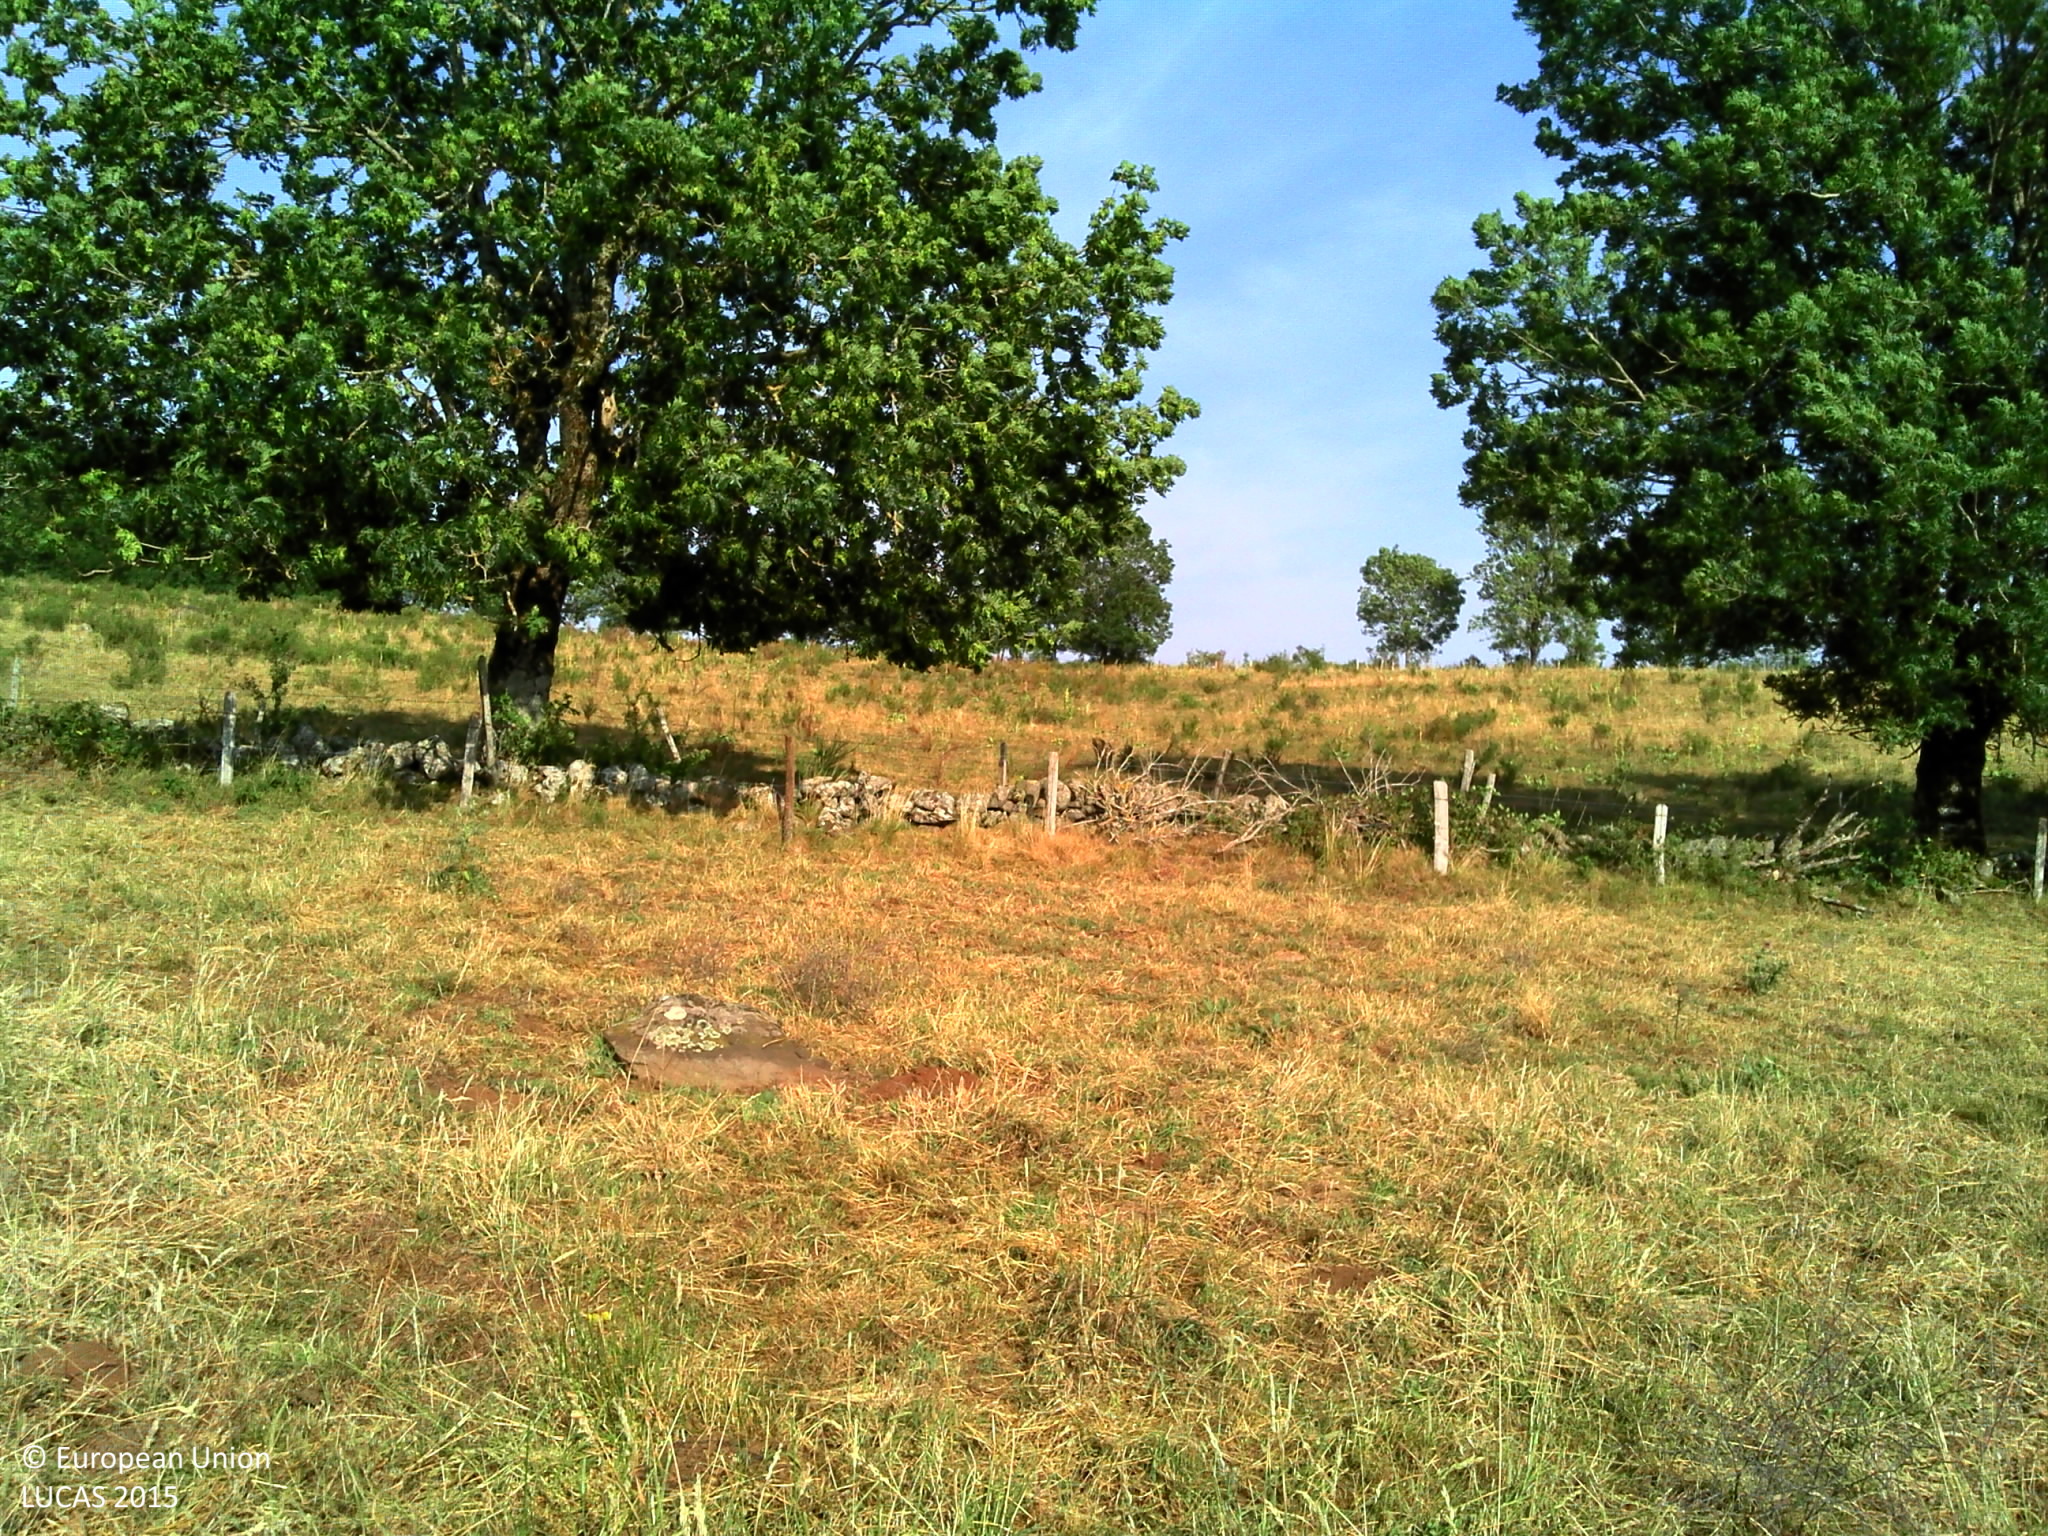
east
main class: Grassland
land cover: Grassland without tree/shrub cover
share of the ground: > 75 %
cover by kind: herbaceous plants 100 %
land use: Agriculture (excluding fallow land and kitchen gardens)
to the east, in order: Grassland without tree/shrub cover; Fences; Dry stone walls; Lines of trees; Fences; Grassland without tree/shrub cover; Broadleaved woodland; Fences; Tracks; Fences; Grassland without tree/shrub cover; Fences; Grassland without tree/shrub cover
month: July
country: FR
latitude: 44.5804
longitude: 2.9382
